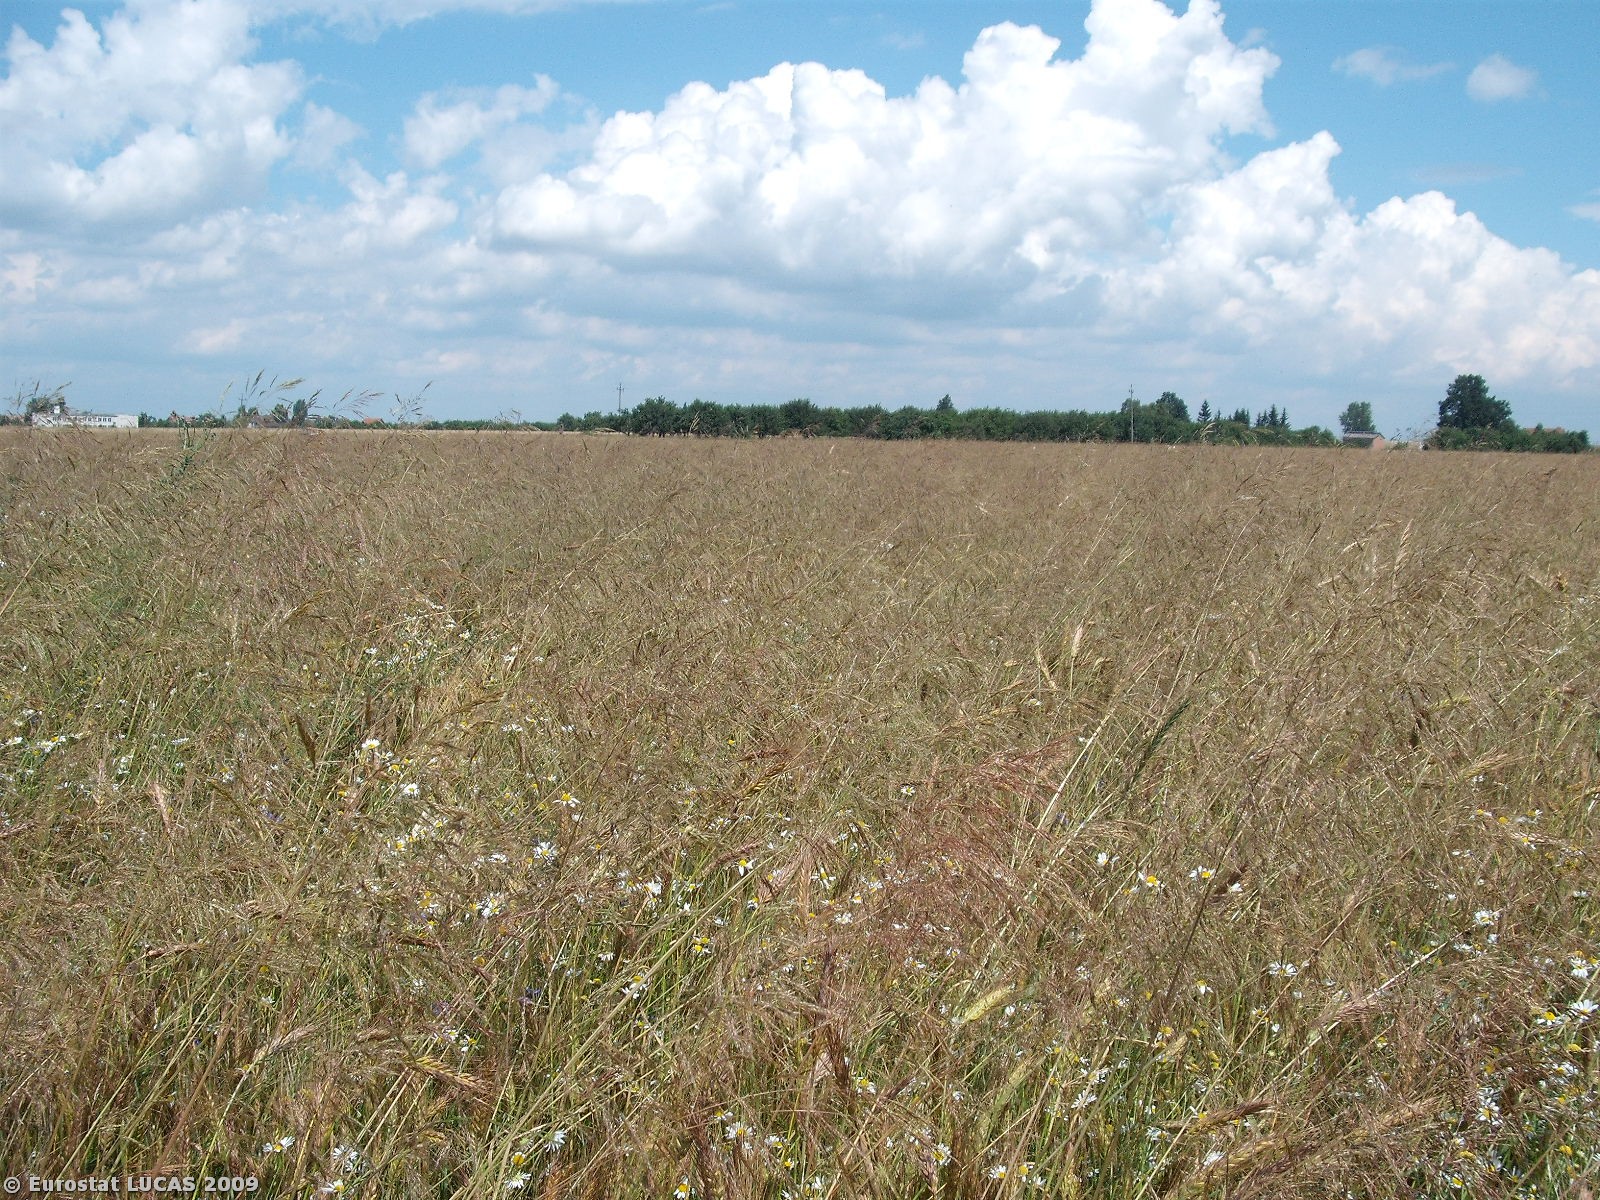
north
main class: Cropland
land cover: Triticale
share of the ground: > 75 %
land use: Agriculture (excluding fallow land and kitchen gardens)
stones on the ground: 10 - 25 %
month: July
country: PL
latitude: 51.4422
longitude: 21.0514
